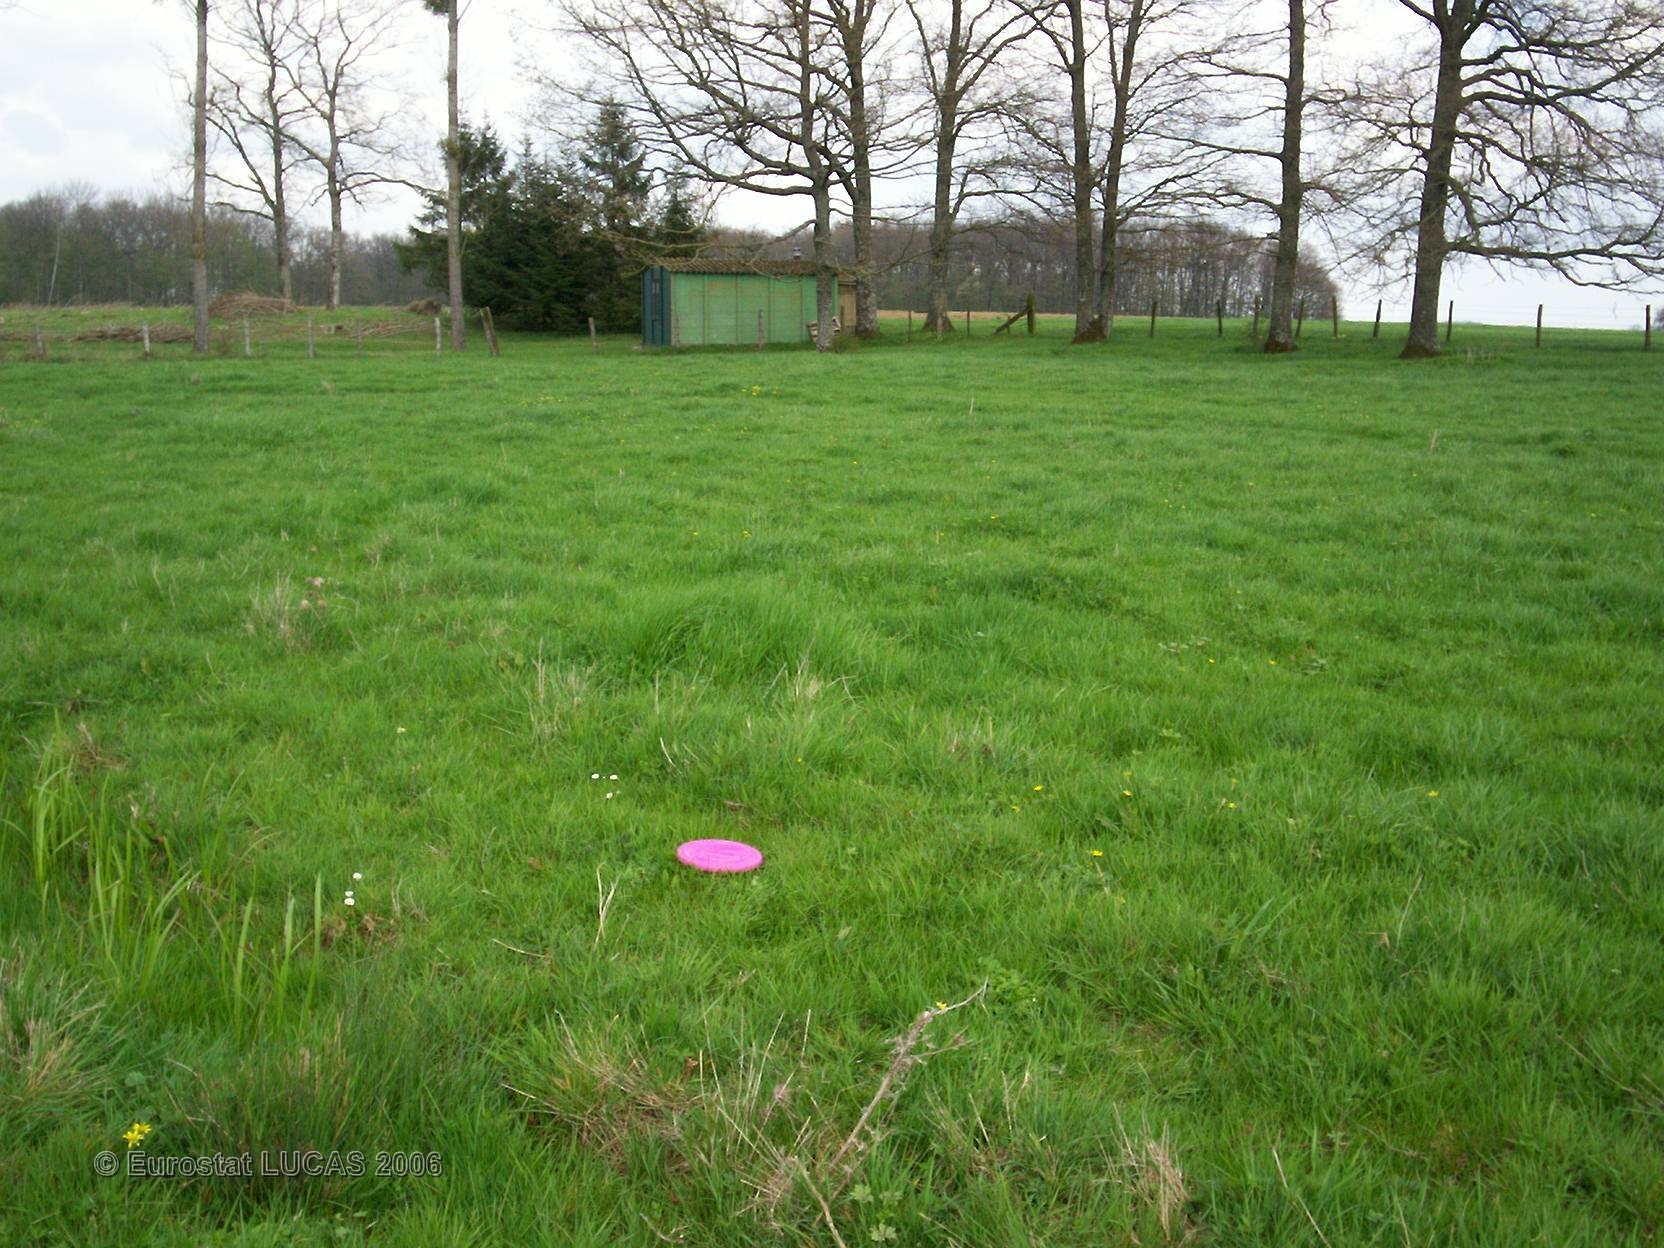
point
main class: Grassland
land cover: Grassland without tree/shrub cover
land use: Agriculture (excluding fallow land and kitchen gardens)
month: April
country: FR
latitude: 48.5264
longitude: 4.6490
